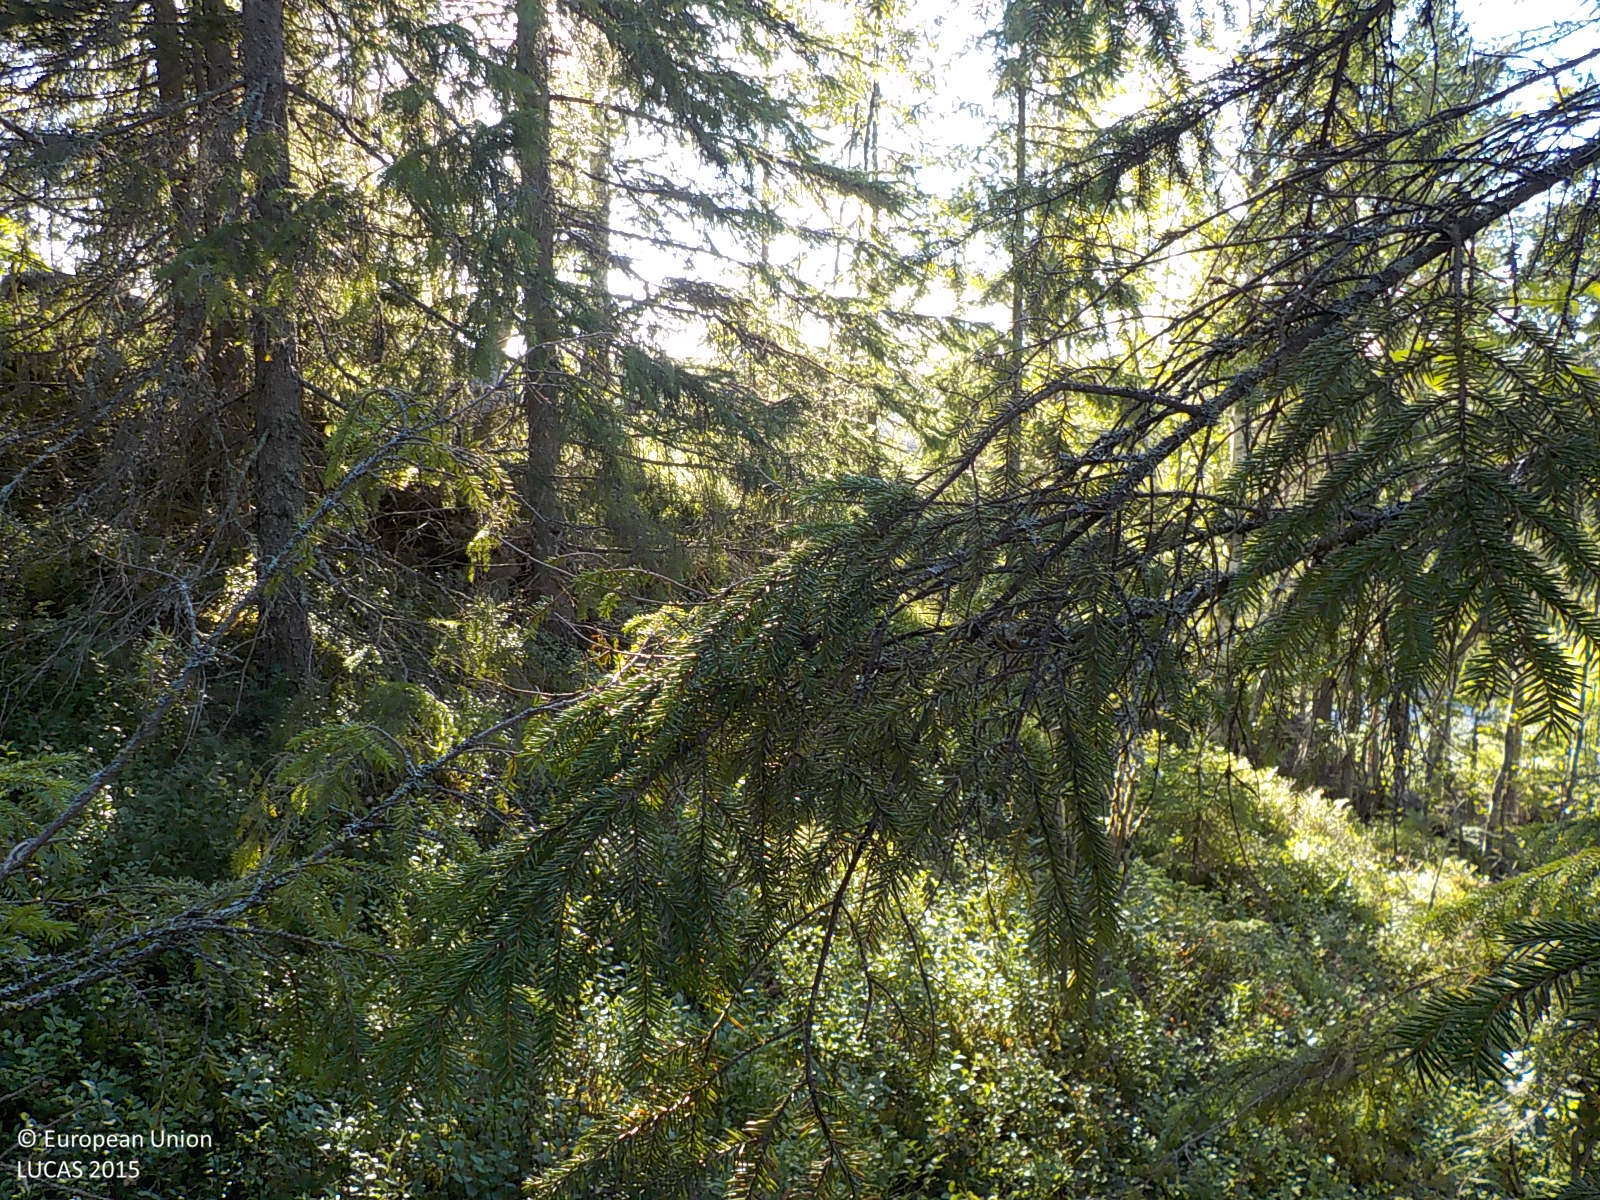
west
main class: Woodland
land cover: Spruce dominated coniferous woodland
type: boreal forest
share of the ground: 50 - 75 %
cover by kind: coniferous forest trees 75 %, shrubs 25 %
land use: Forestry
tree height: > 5 m
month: August
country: SE
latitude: 63.3720
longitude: 18.7973
